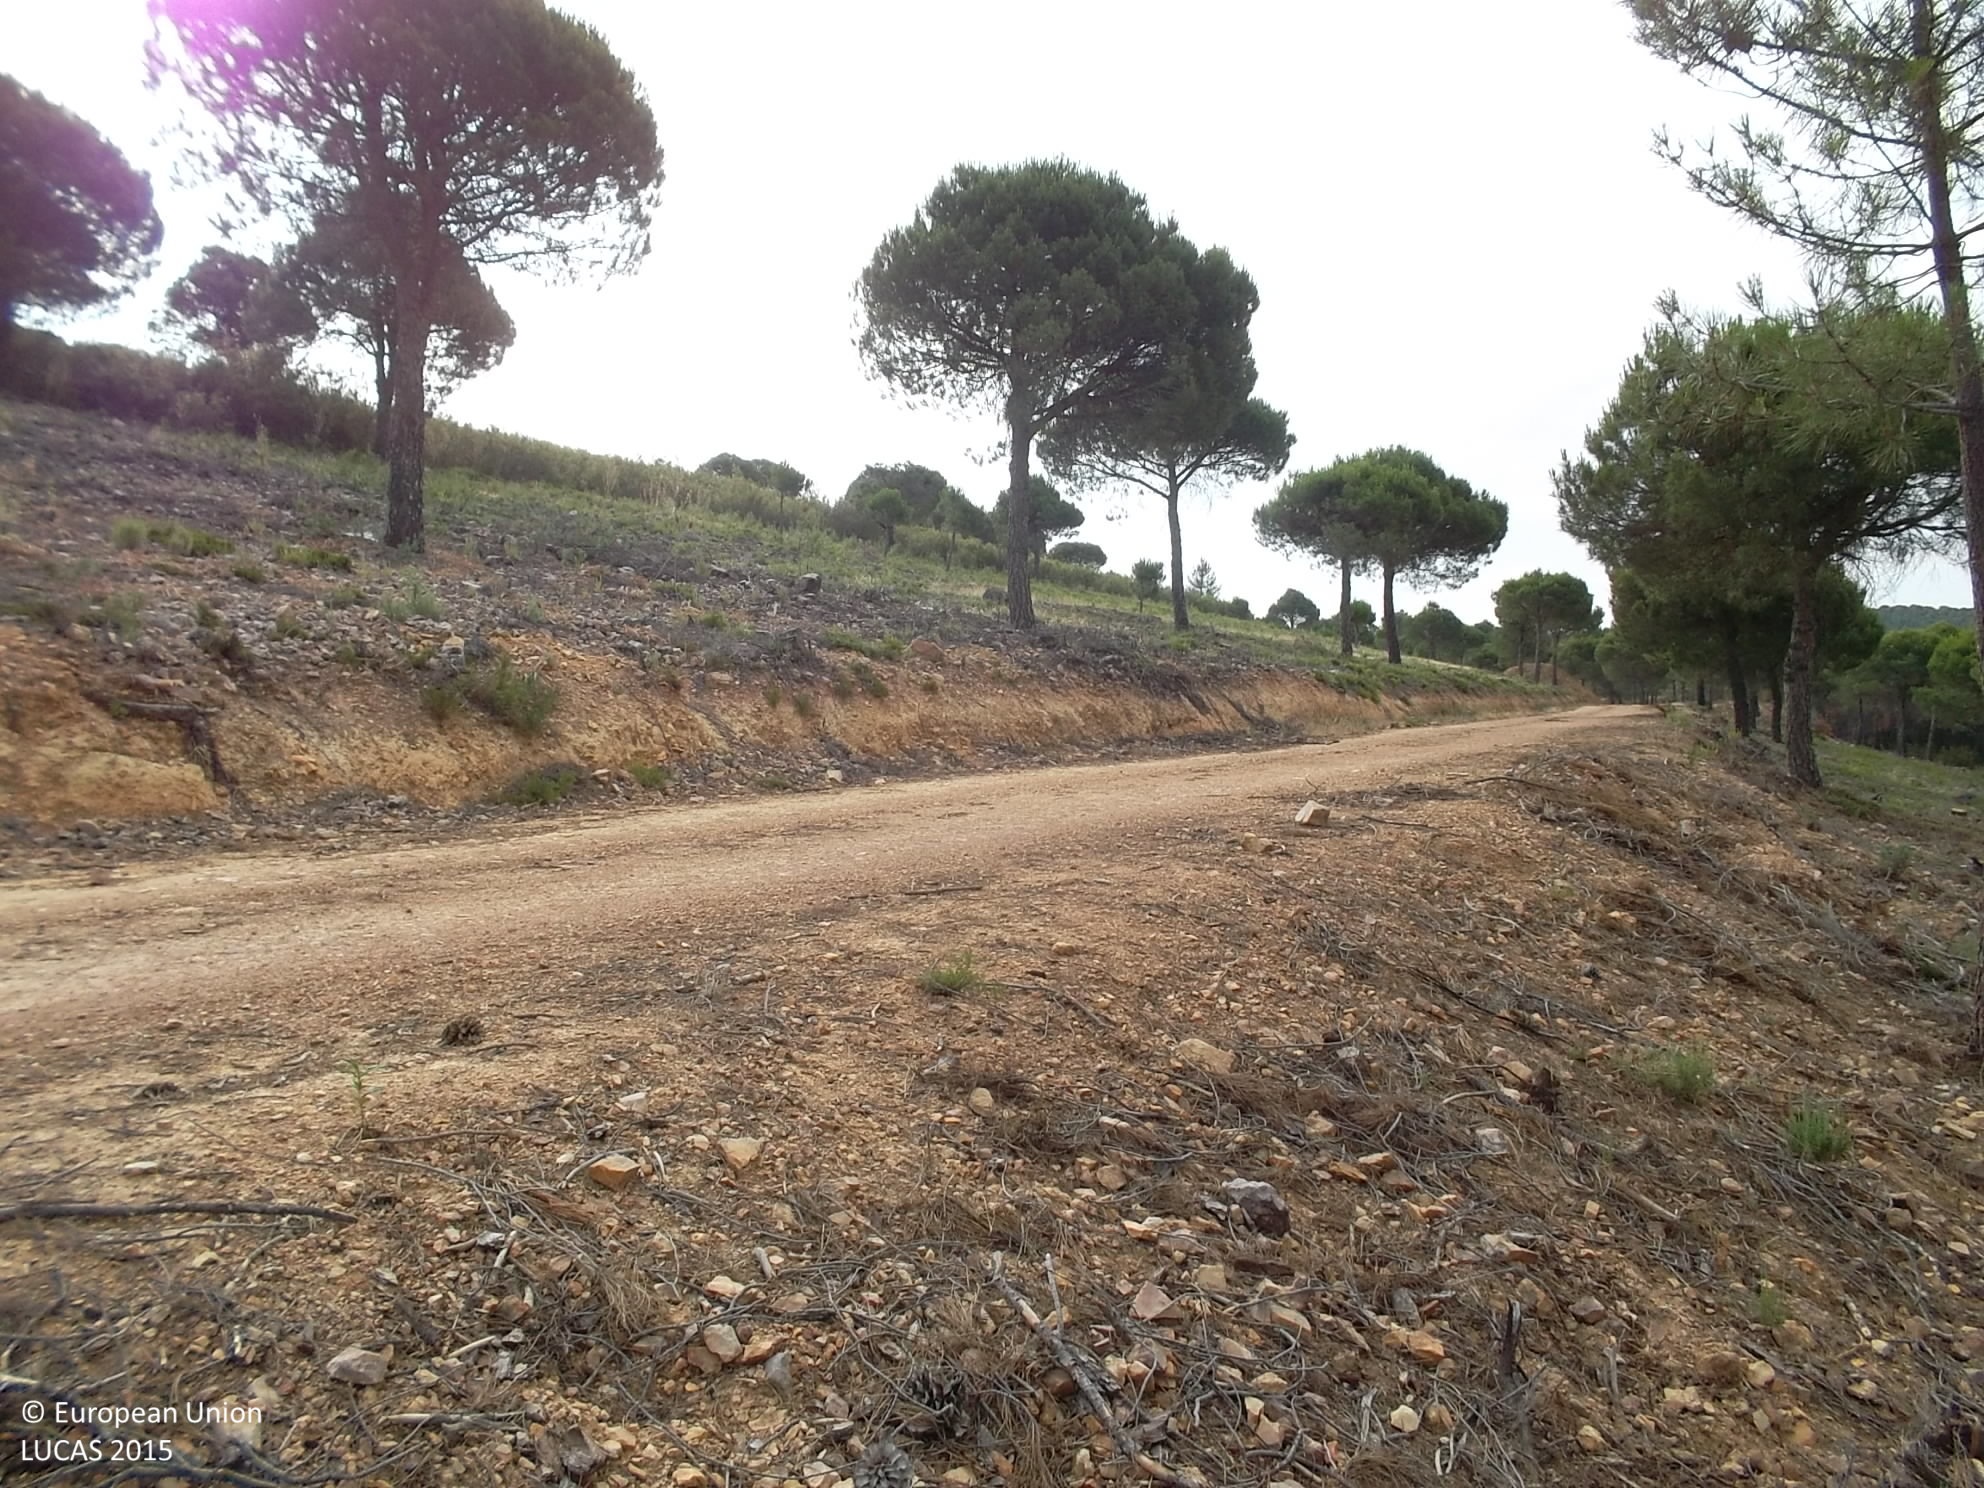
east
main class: Woodland
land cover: Pine dominated coniferous woodland
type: coniferous forest of the mediterranean region
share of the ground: 50 - 75 %
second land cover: Spontaneously vegetated surfaces
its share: > 75 %
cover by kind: coniferous forest trees 40 %, herbaceous plants 40 %, unconsolidated bare surface 20 %
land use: Forestry
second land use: Agriculture (excluding fallow land and kitchen gardens)
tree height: > 5 m
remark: Clear cut
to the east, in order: Pine dominated coniferous woodland; Spontaneously vegetated surfaces; Tracks; Pine dominated coniferous woodland; Grassland with sparse tree/shrub cover; Pine dominated coniferous woodland; Shrubland with sparse tree cover; Shrubland without tree cover
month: June
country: ES
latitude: 39.1828
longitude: -4.8660
